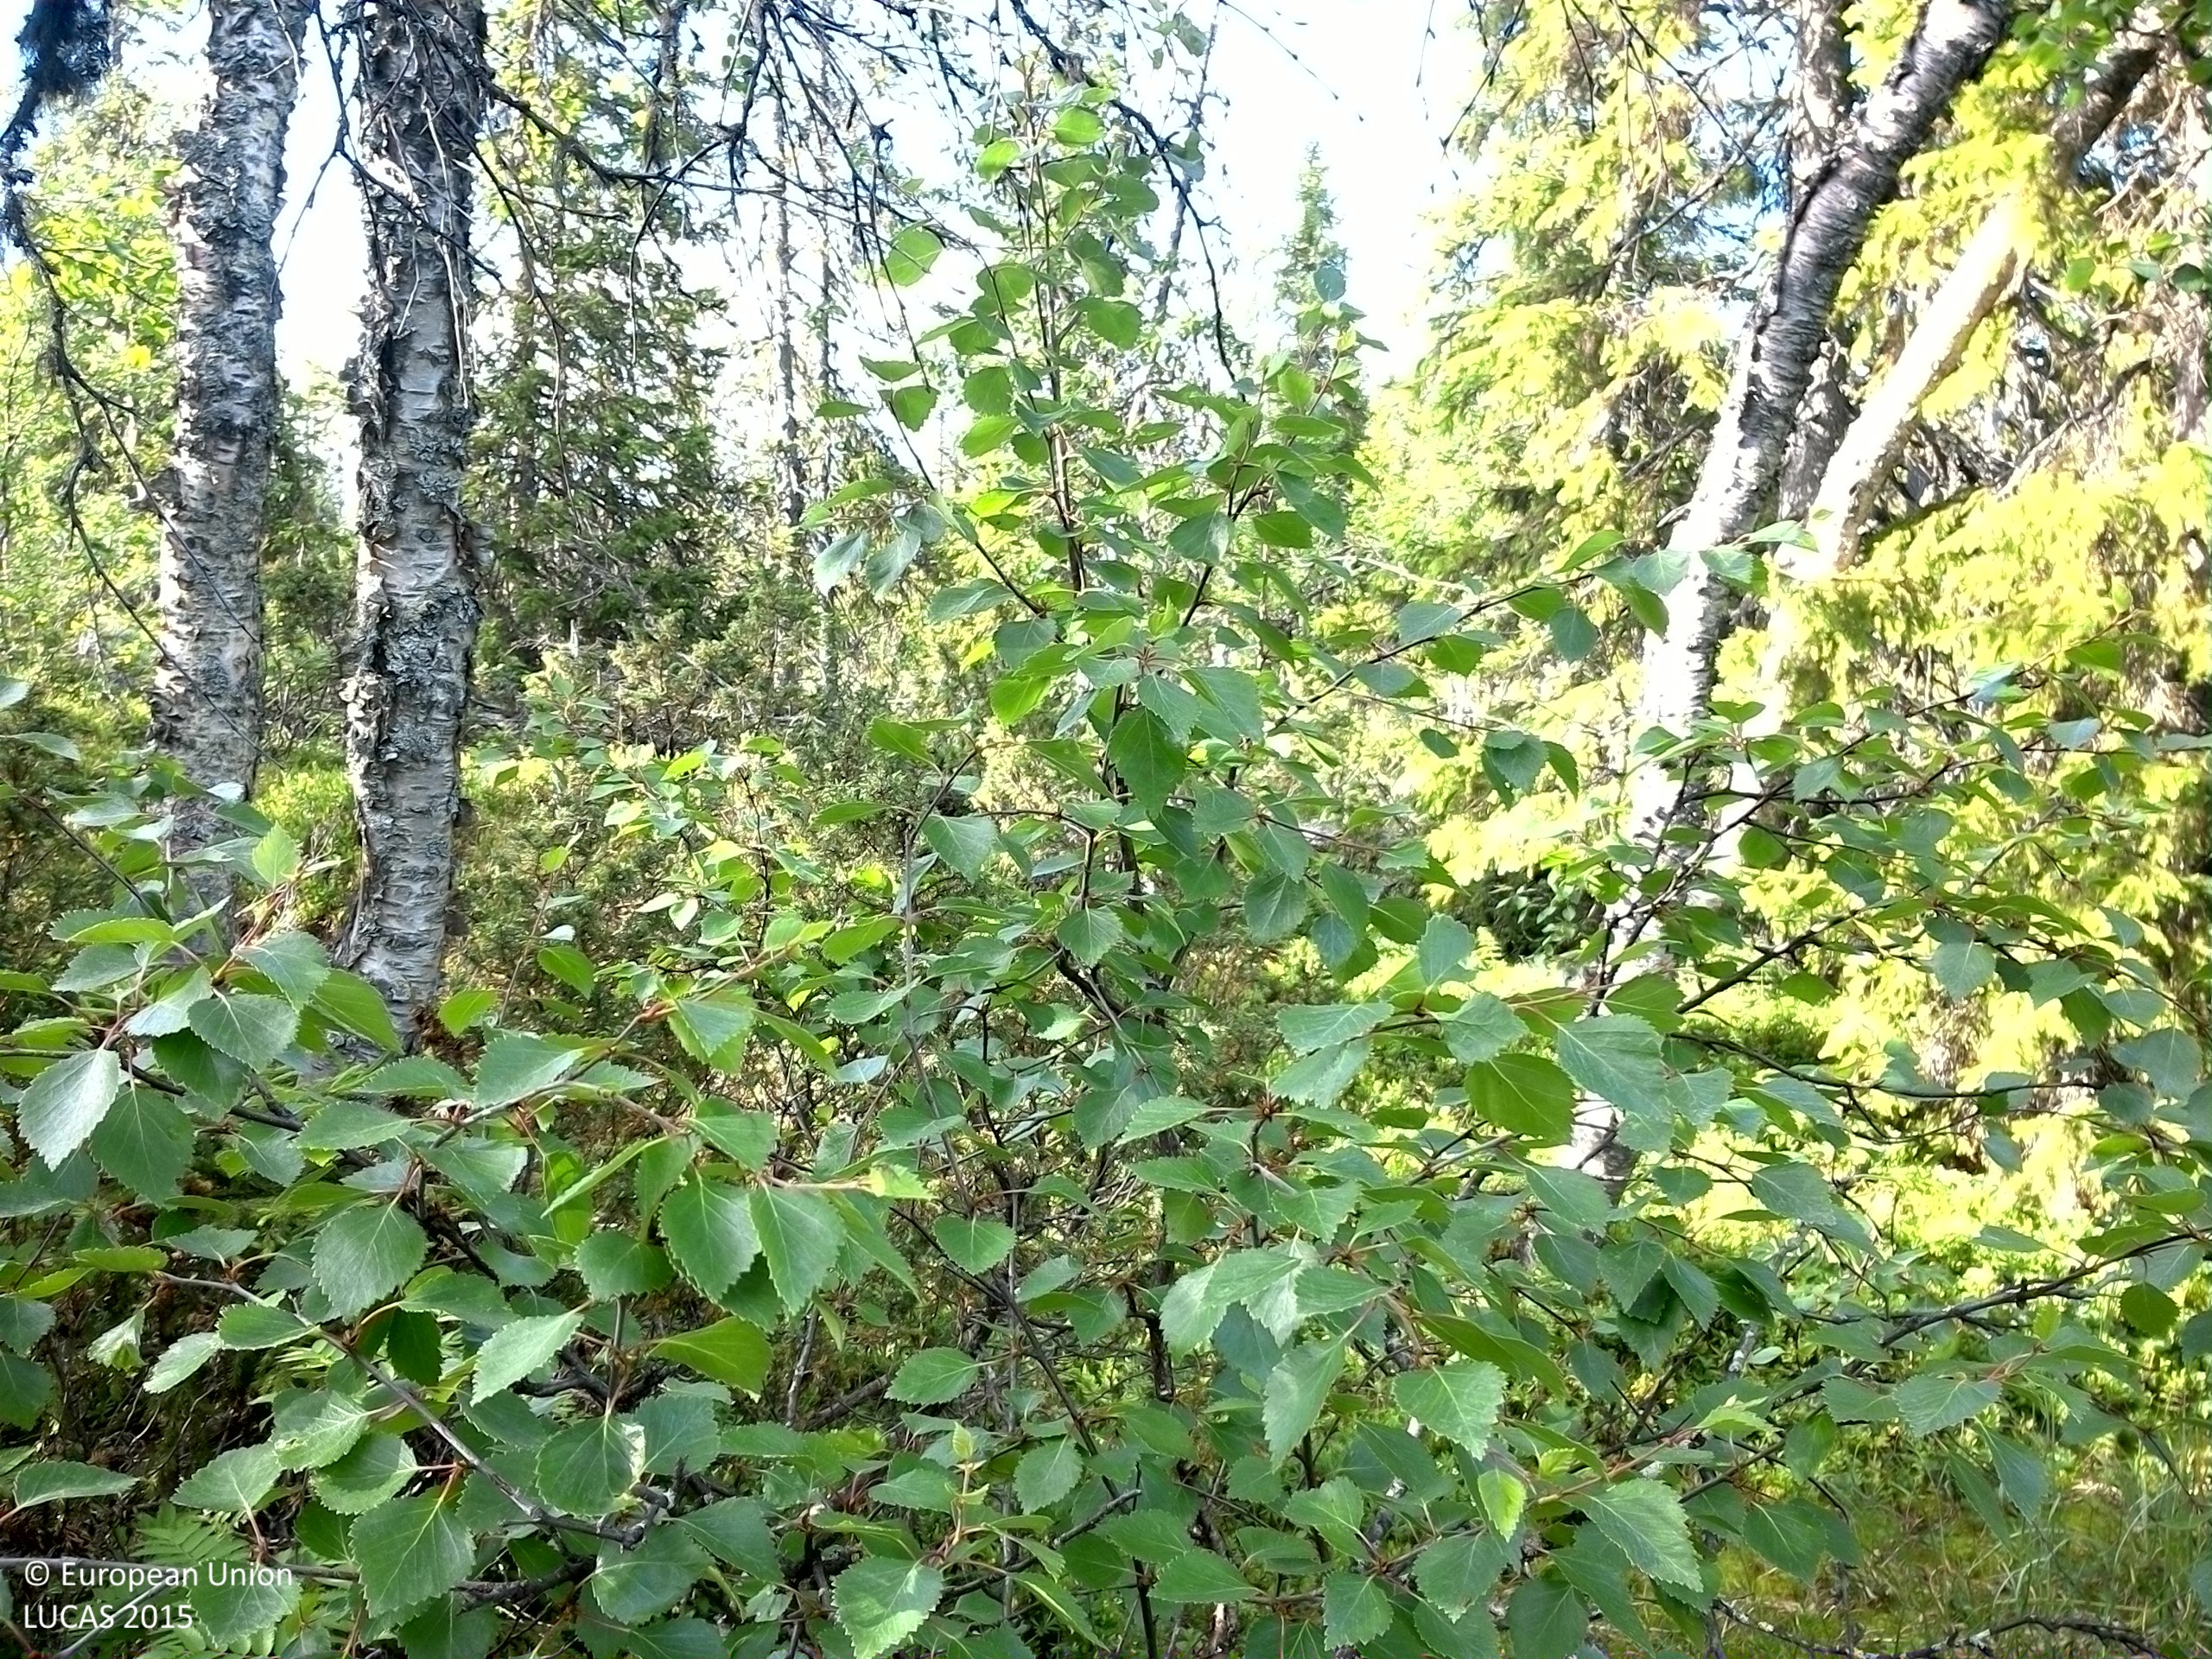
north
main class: Woodland
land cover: Spruce dominated mixed woodland
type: boreal forest
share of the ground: 25 - 50 %
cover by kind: shrubs 40 %, coniferous forest trees 30 %, broadleaved forest trees 15 %, lichens and mosses 10 %, herbaceous plants 5 %
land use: Forestry
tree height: > 5 m
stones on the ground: < 10 %
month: July
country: SE
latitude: 64.6892
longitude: 15.3154
